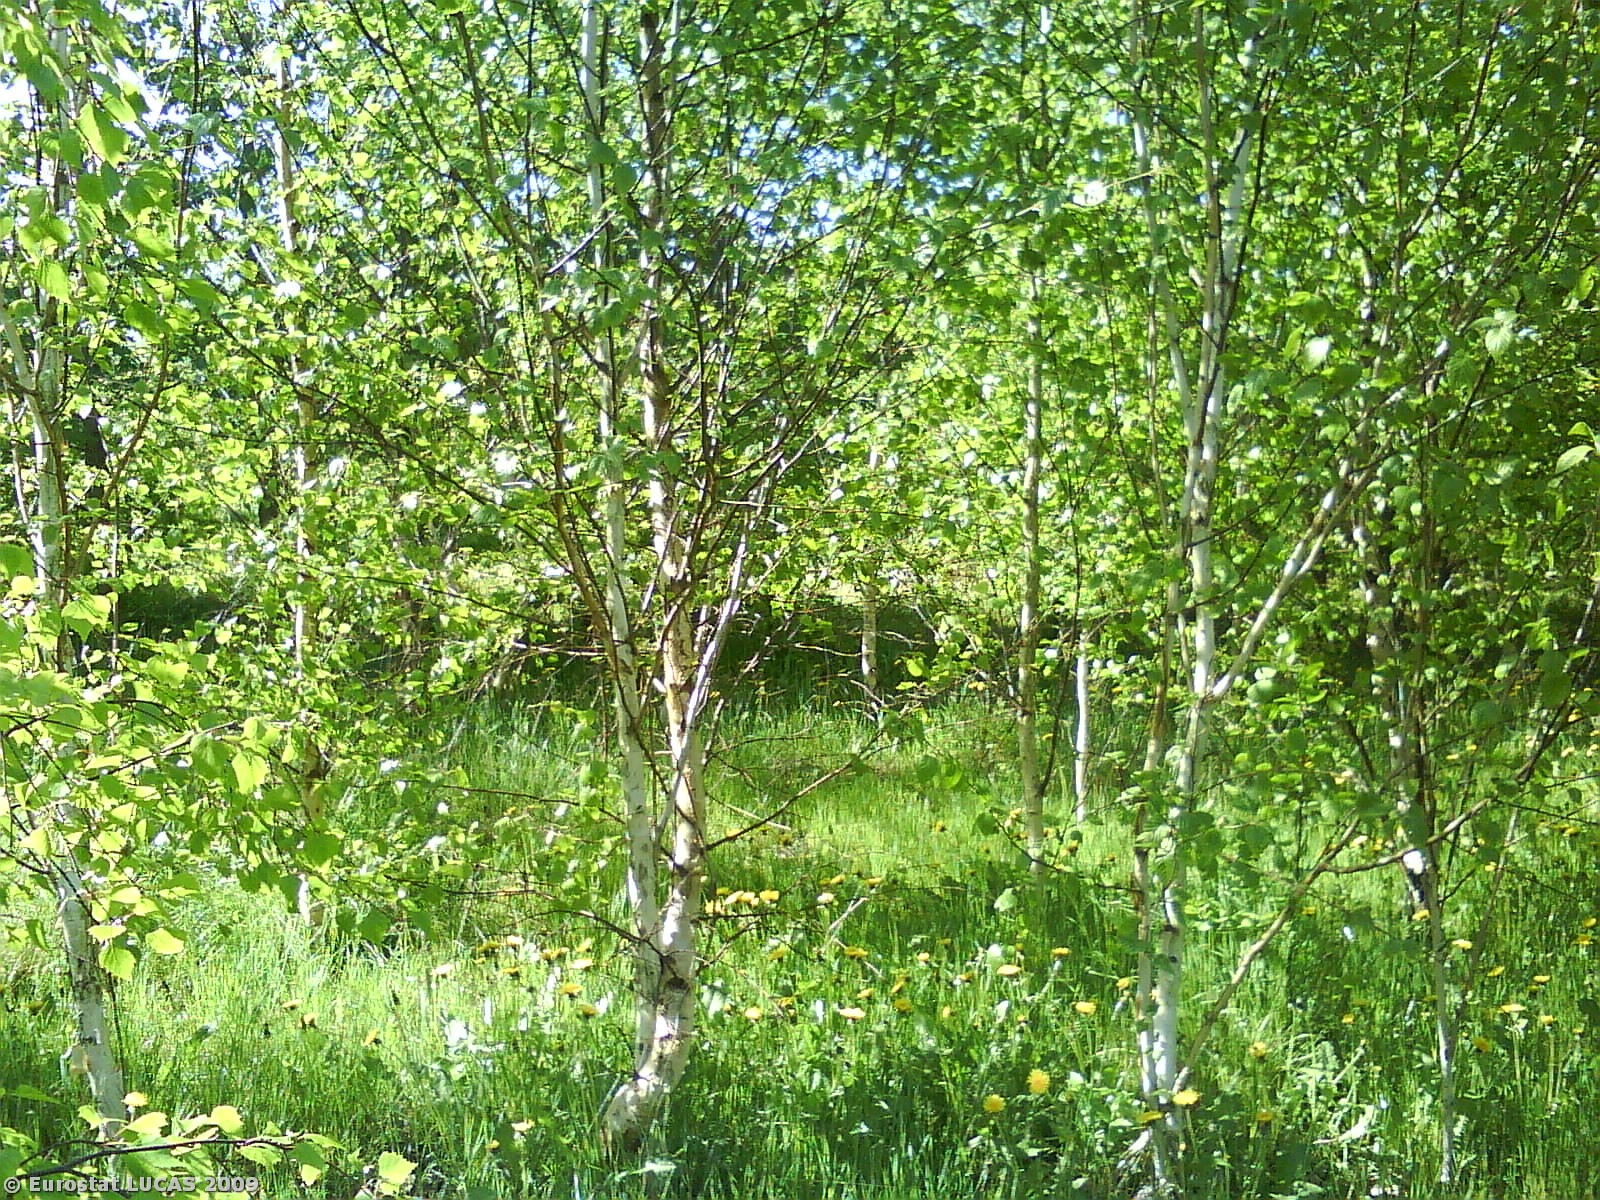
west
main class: Woodland
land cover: Broadleaved woodland
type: plantations and self-sown exotic forest
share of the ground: 25 - 50 %
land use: Unused
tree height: > 5 m
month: May
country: DK
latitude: 56.3473
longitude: 10.7595
